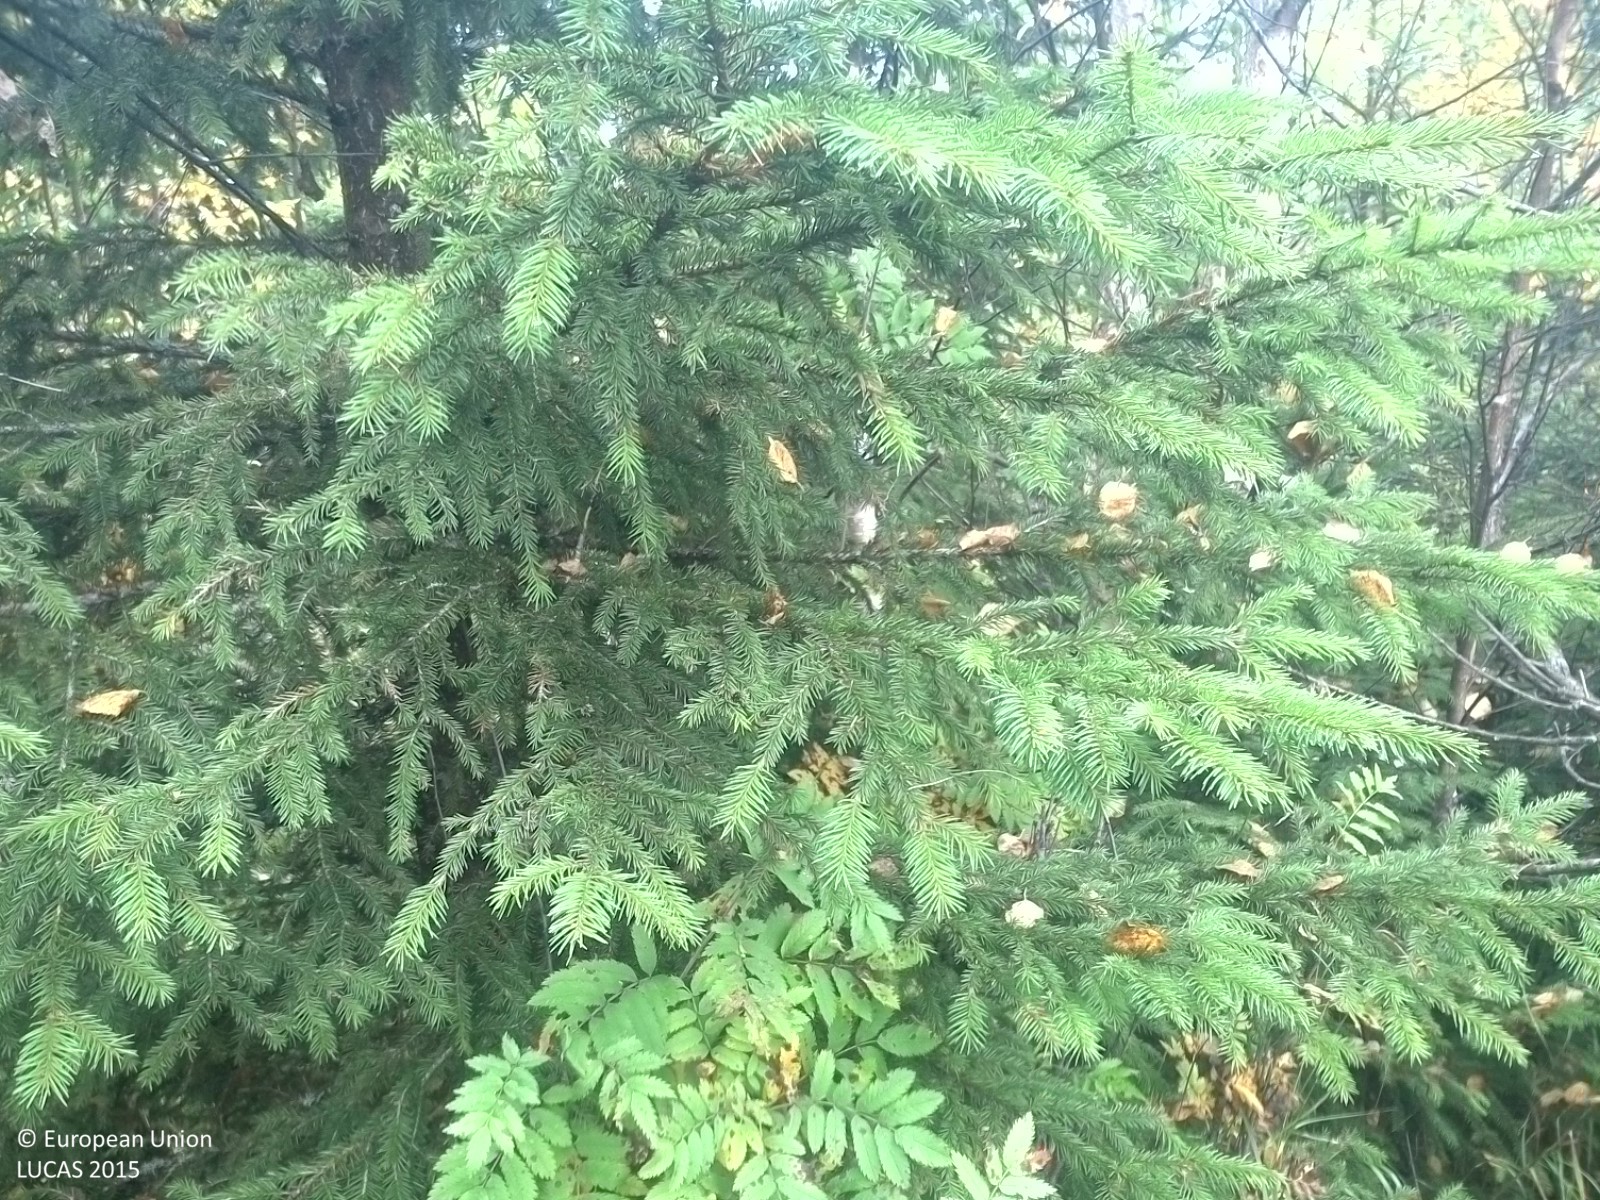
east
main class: Woodland
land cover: Spruce dominated mixed woodland
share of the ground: 25 - 50 %
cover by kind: herbaceous plants 50 %, coniferous forest trees 25 %, shrubs 15 %, broadleaved forest trees 10 %
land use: Forestry
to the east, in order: Spruce dominated mixed woodland; Ditches and canals; Spruce dominated mixed woodland; Grass margins; Paved roads, cycling and walking lanes; Ditches and canals; Broadleaved woodland; Spruce dominated mixed woodland; Ditches and canals; Paved roads, cycling and walking lanes
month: September
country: SE
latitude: 62.0898
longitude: 15.6690
